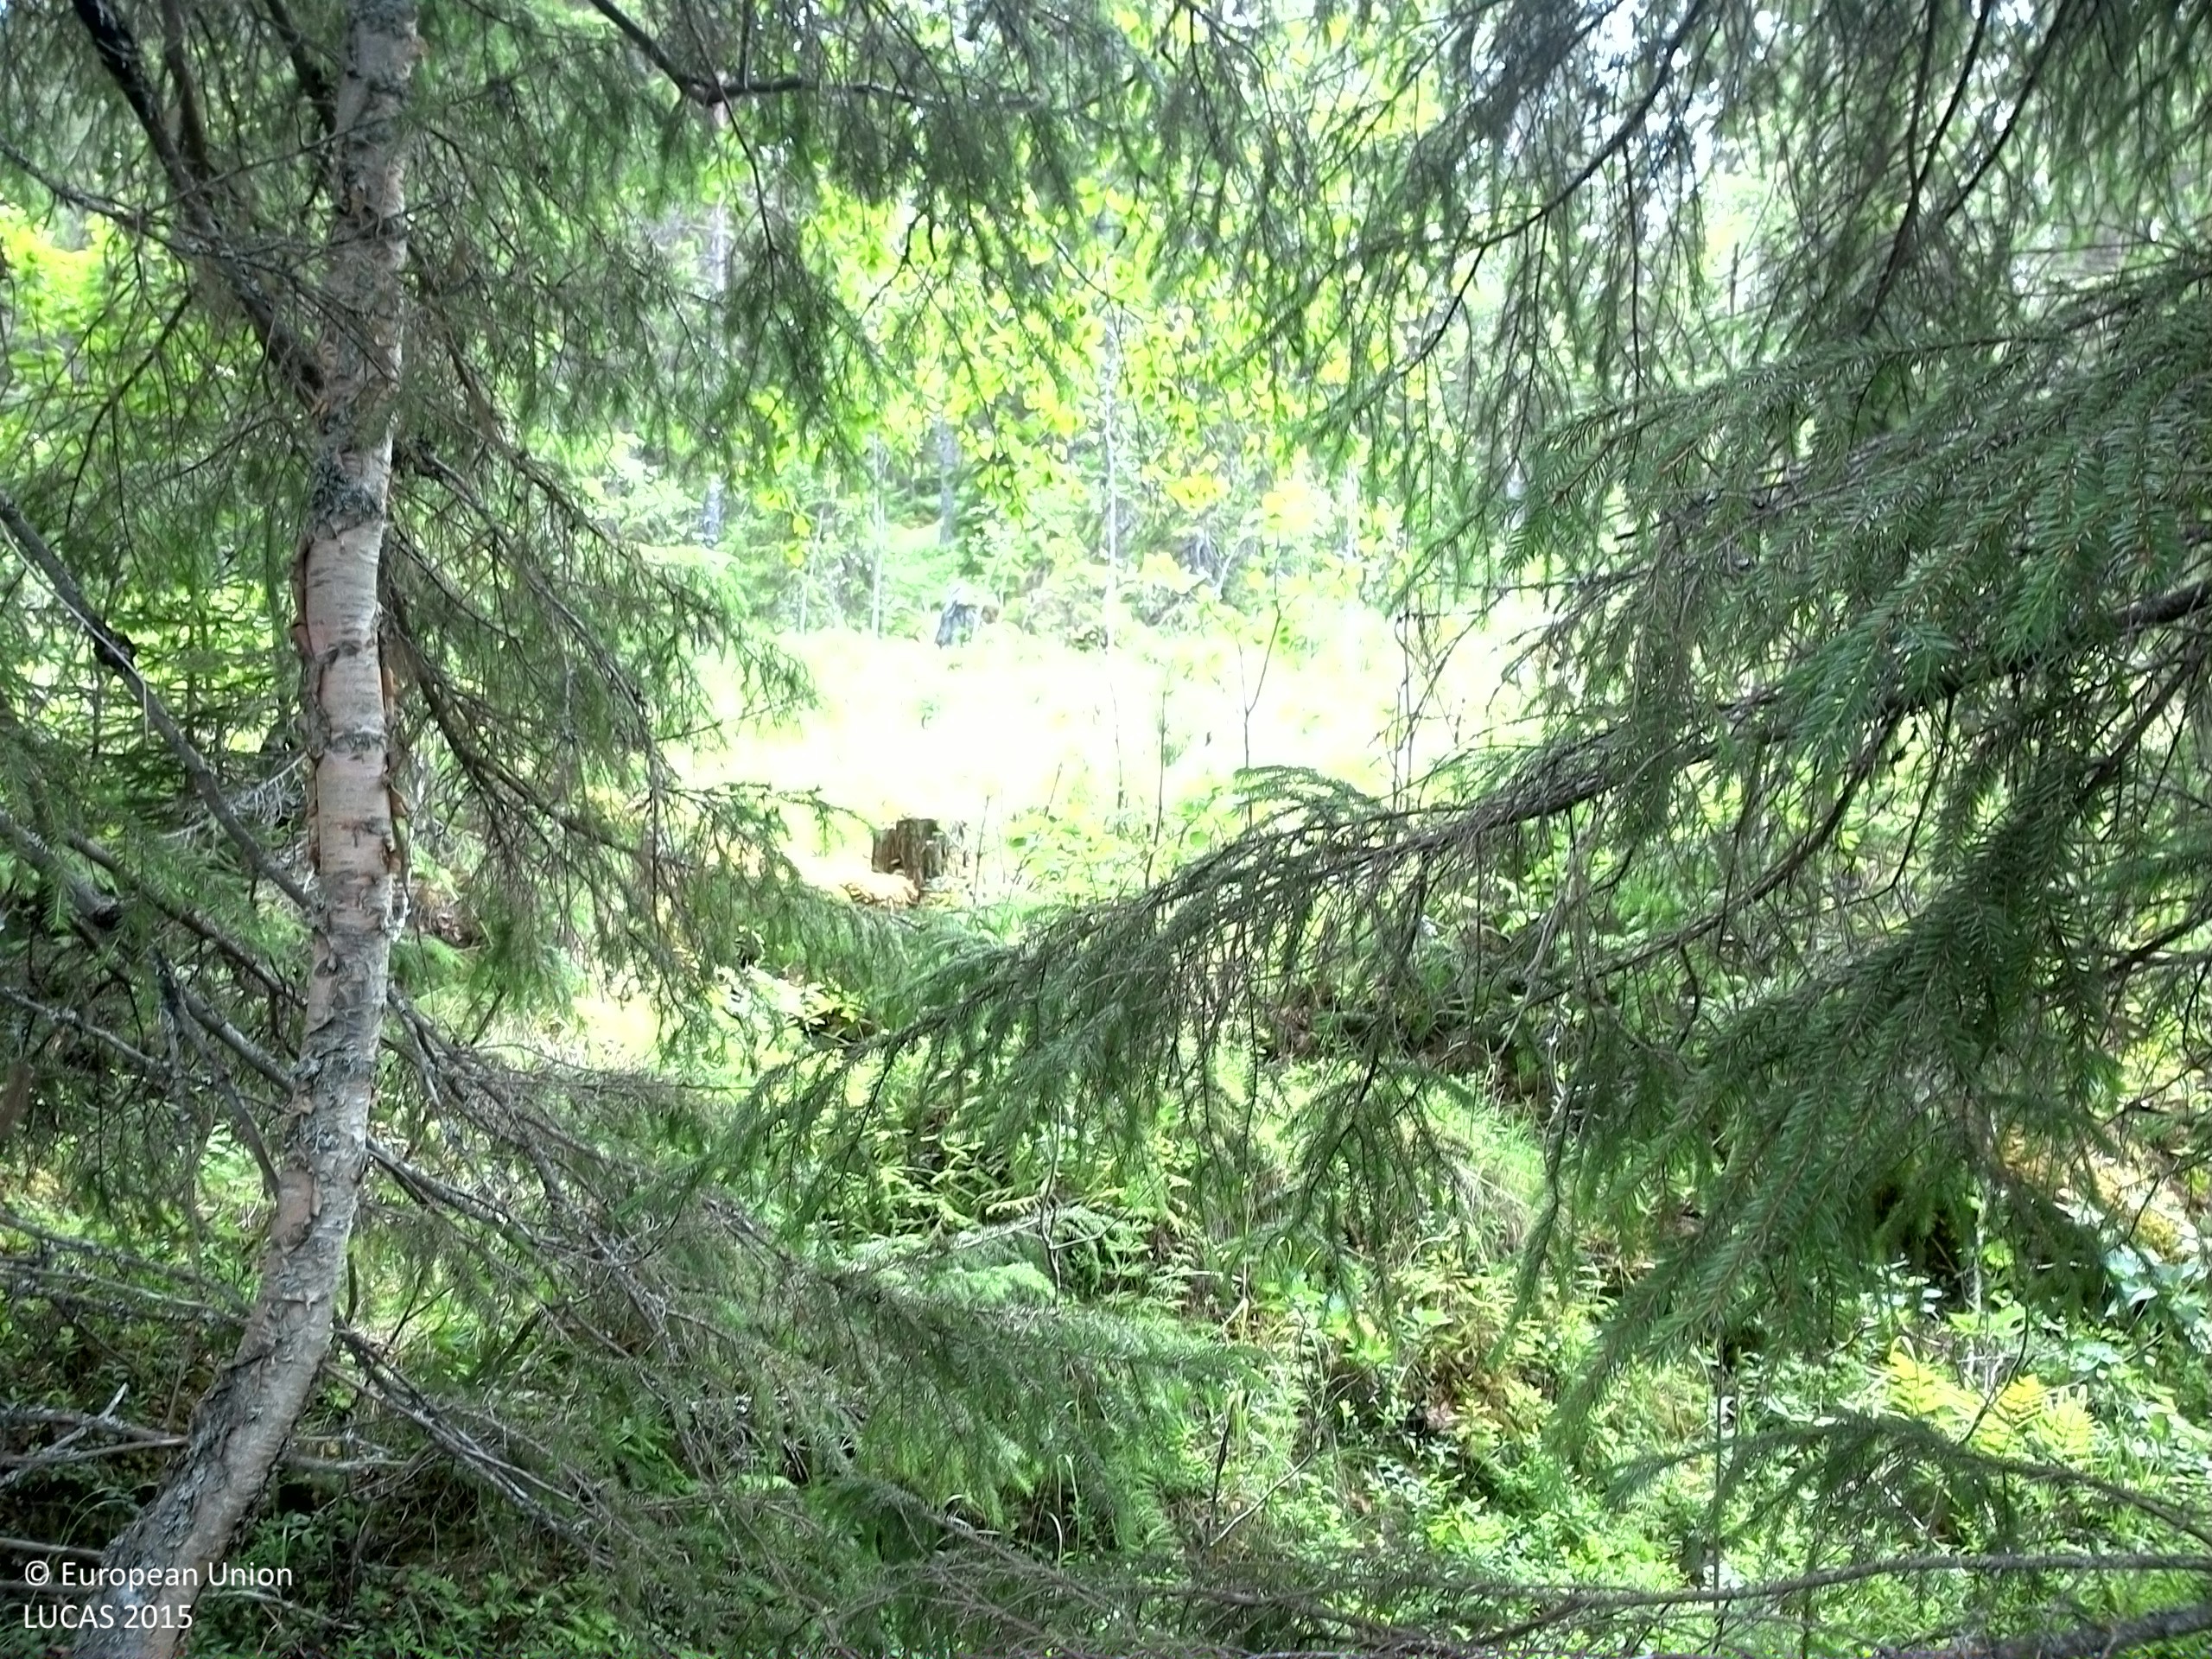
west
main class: Woodland
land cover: Spruce dominated mixed woodland
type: boreal forest
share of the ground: > 75 %
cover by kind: coniferous forest trees 60 %, broadleaved forest trees 20 %, shrubs 20 %
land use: Forestry
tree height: > 5 m
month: July
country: SE
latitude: 62.7622
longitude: 17.2833
